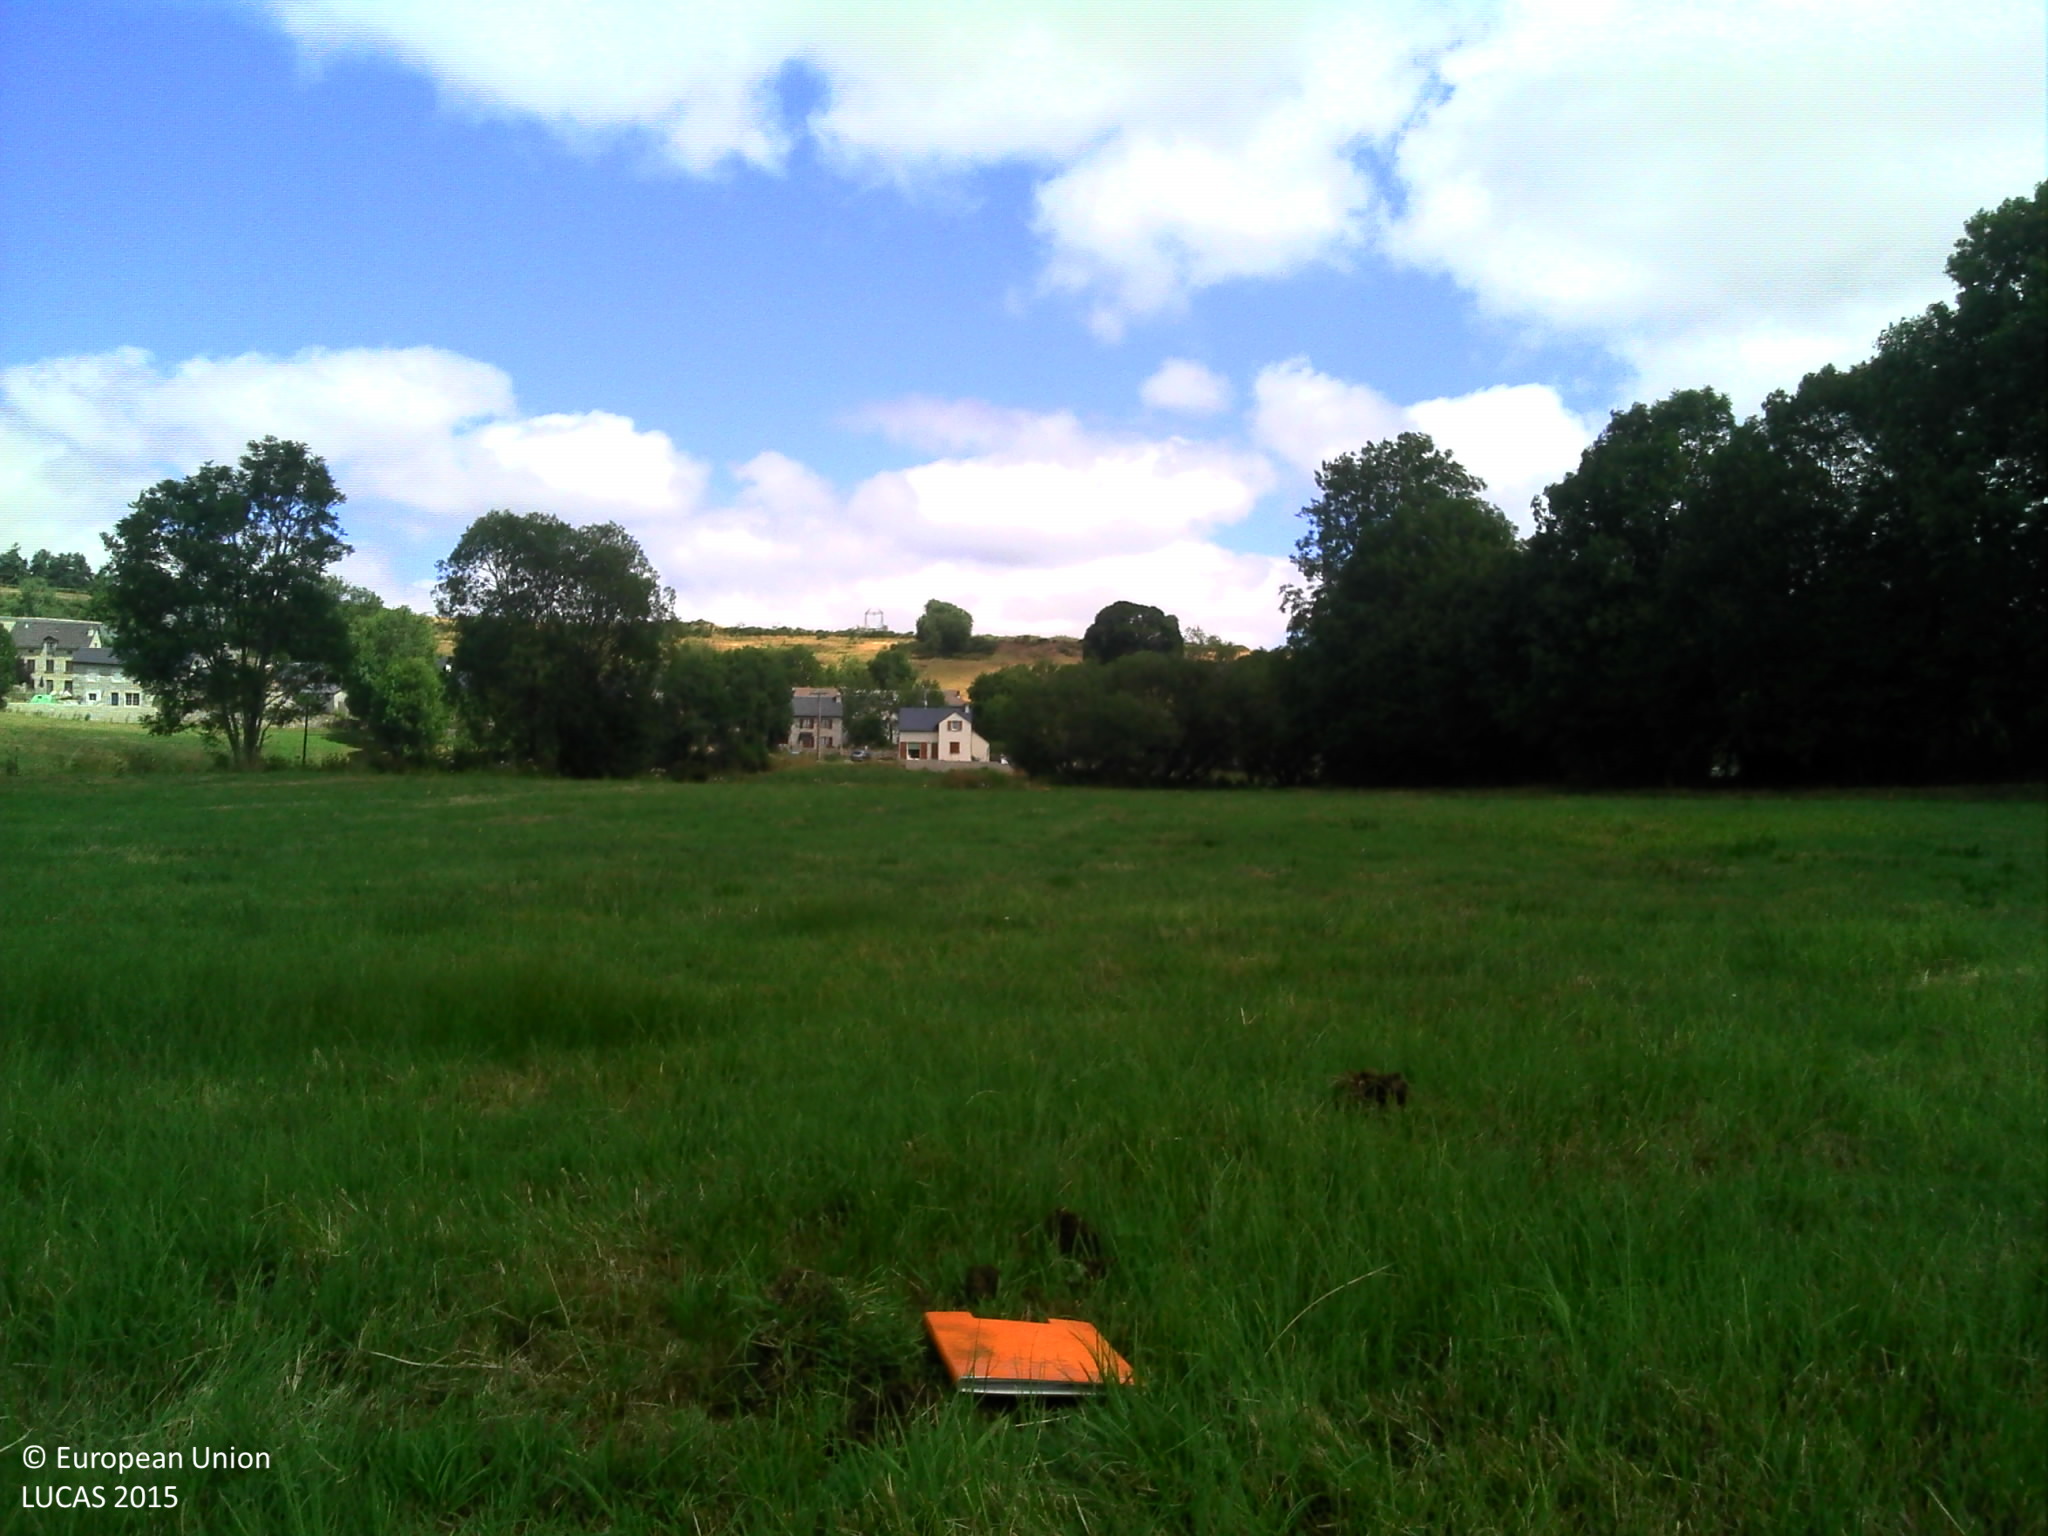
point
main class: Grassland
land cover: Grassland without tree/shrub cover
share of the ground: > 75 %
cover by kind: herbaceous plants 100 %
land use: Agriculture (excluding fallow land and kitchen gardens)
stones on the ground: 10 - 25 %
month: July
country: FR
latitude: 44.8122
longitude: 3.4414
